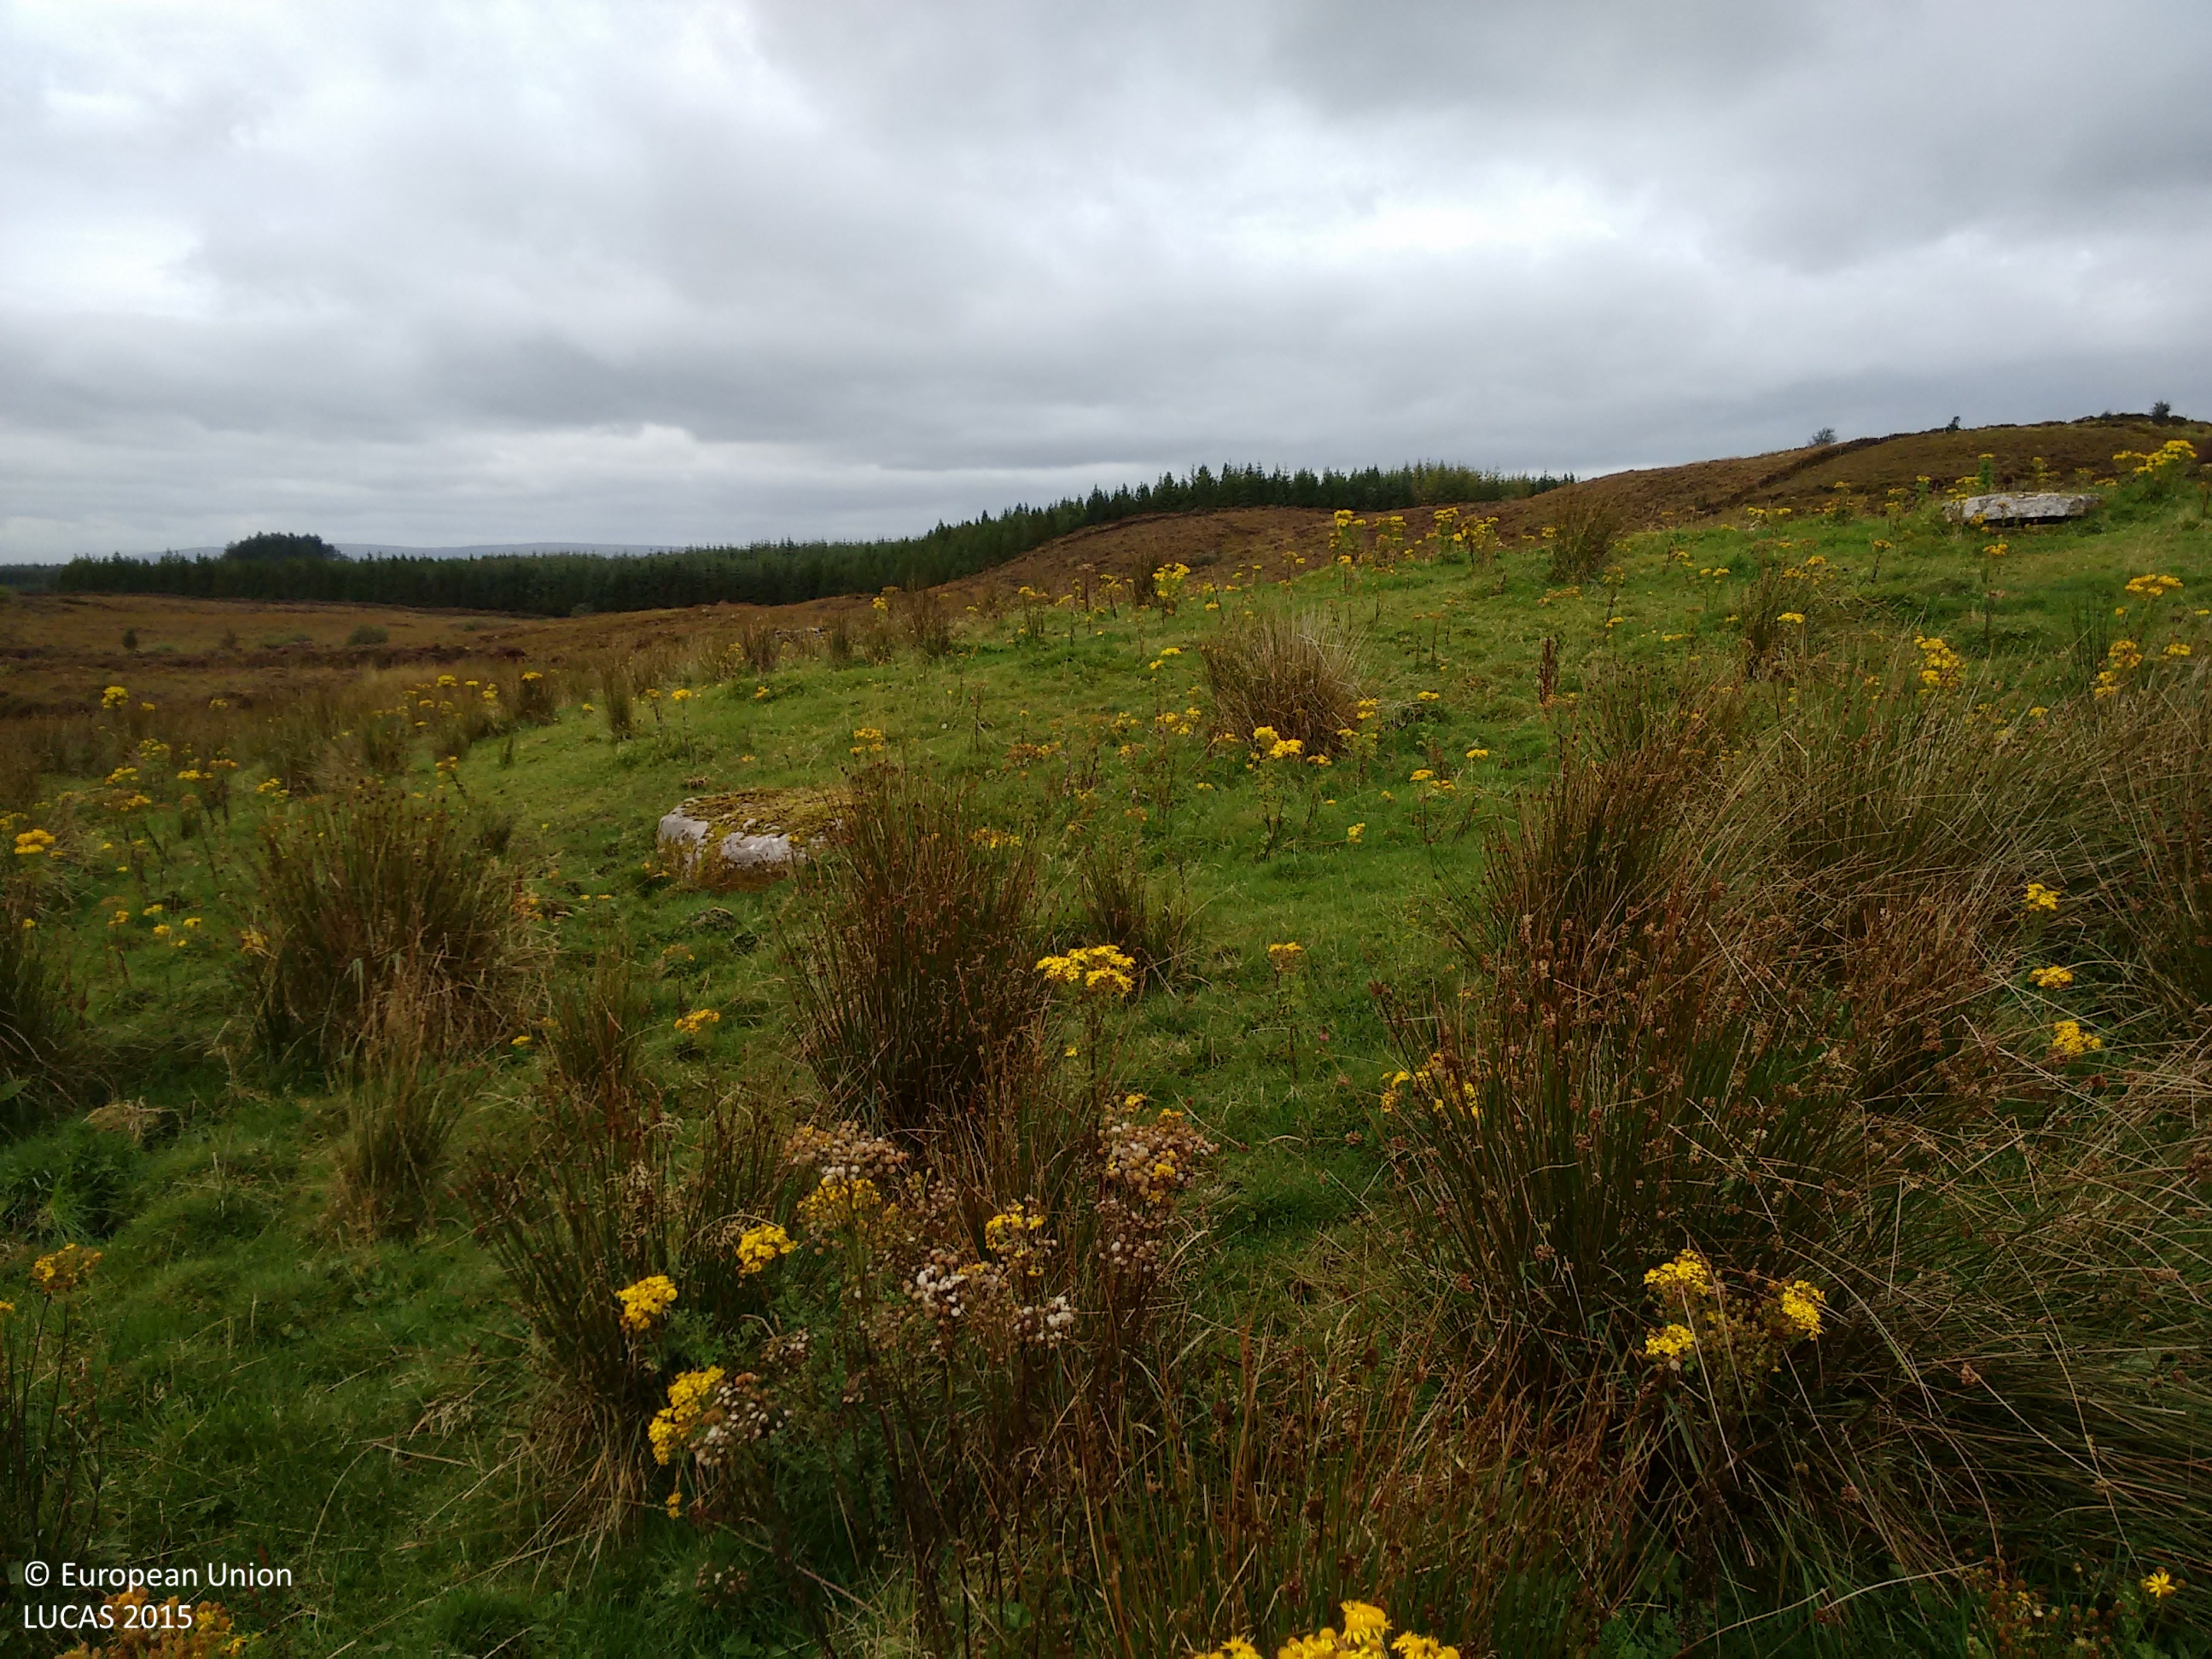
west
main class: Grassland
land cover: Grassland without tree/shrub cover
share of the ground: > 75 %
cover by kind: herbaceous plants 100 %
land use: Agriculture (excluding fallow land and kitchen gardens)
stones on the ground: < 10 %
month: September
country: IE
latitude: 53.8997
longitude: -8.8492
